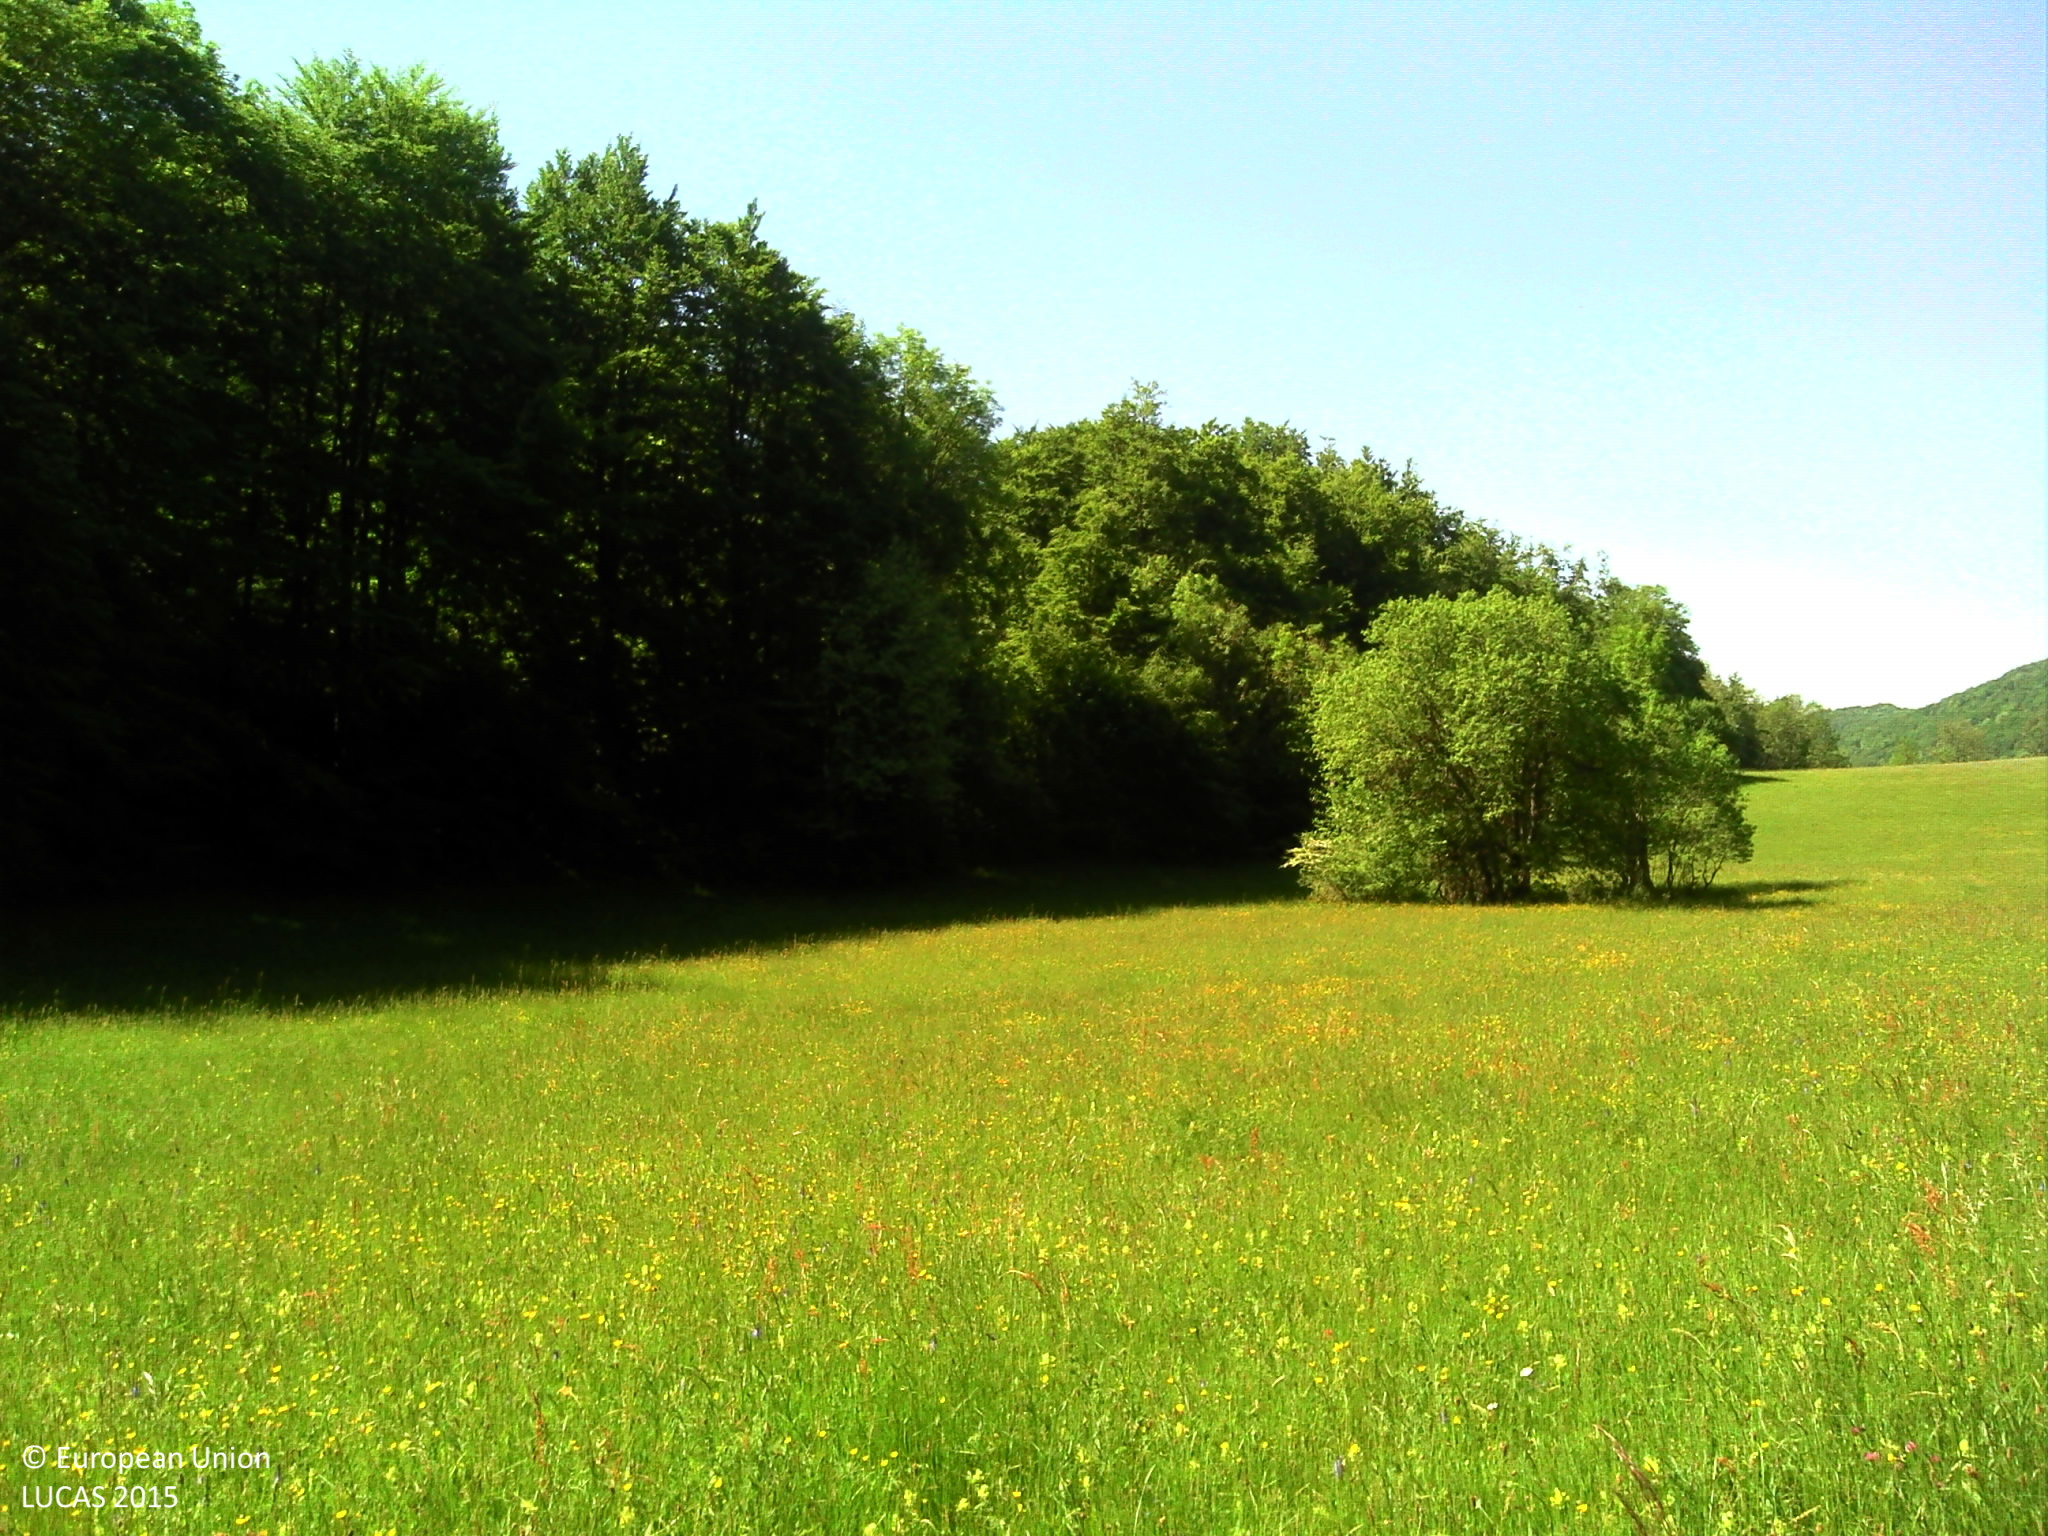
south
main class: Grassland
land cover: Grassland without tree/shrub cover
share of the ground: > 75 %
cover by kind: herbaceous plants 100 %
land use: Agriculture (excluding fallow land and kitchen gardens)
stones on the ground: < 10 %
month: June
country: FR
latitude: 44.9811
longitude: 5.2248
